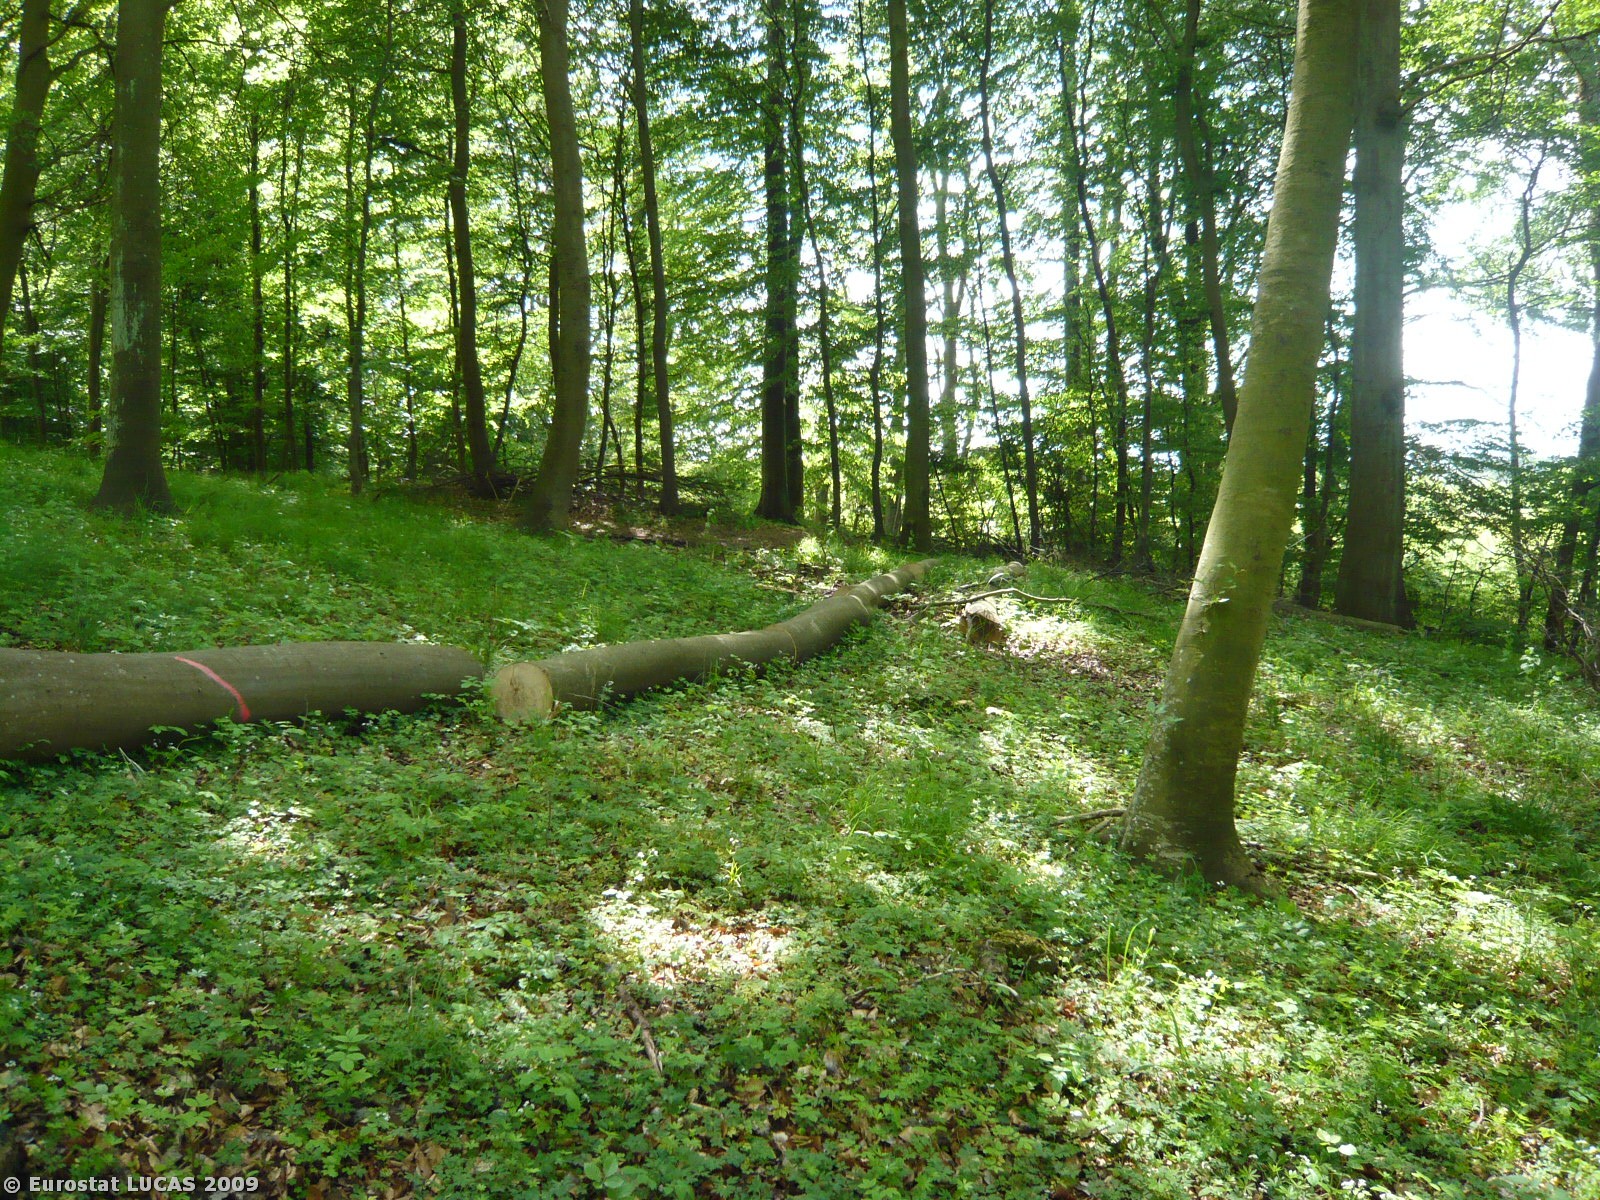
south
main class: Woodland
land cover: Broadleaved woodland
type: mesophytic deciduous forest
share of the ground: > 75 %
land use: Forestry
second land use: Amenities, museums, leisure
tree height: > 5 m
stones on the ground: < 10 %
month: May
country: DK
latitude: 55.6340
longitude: 11.9204
